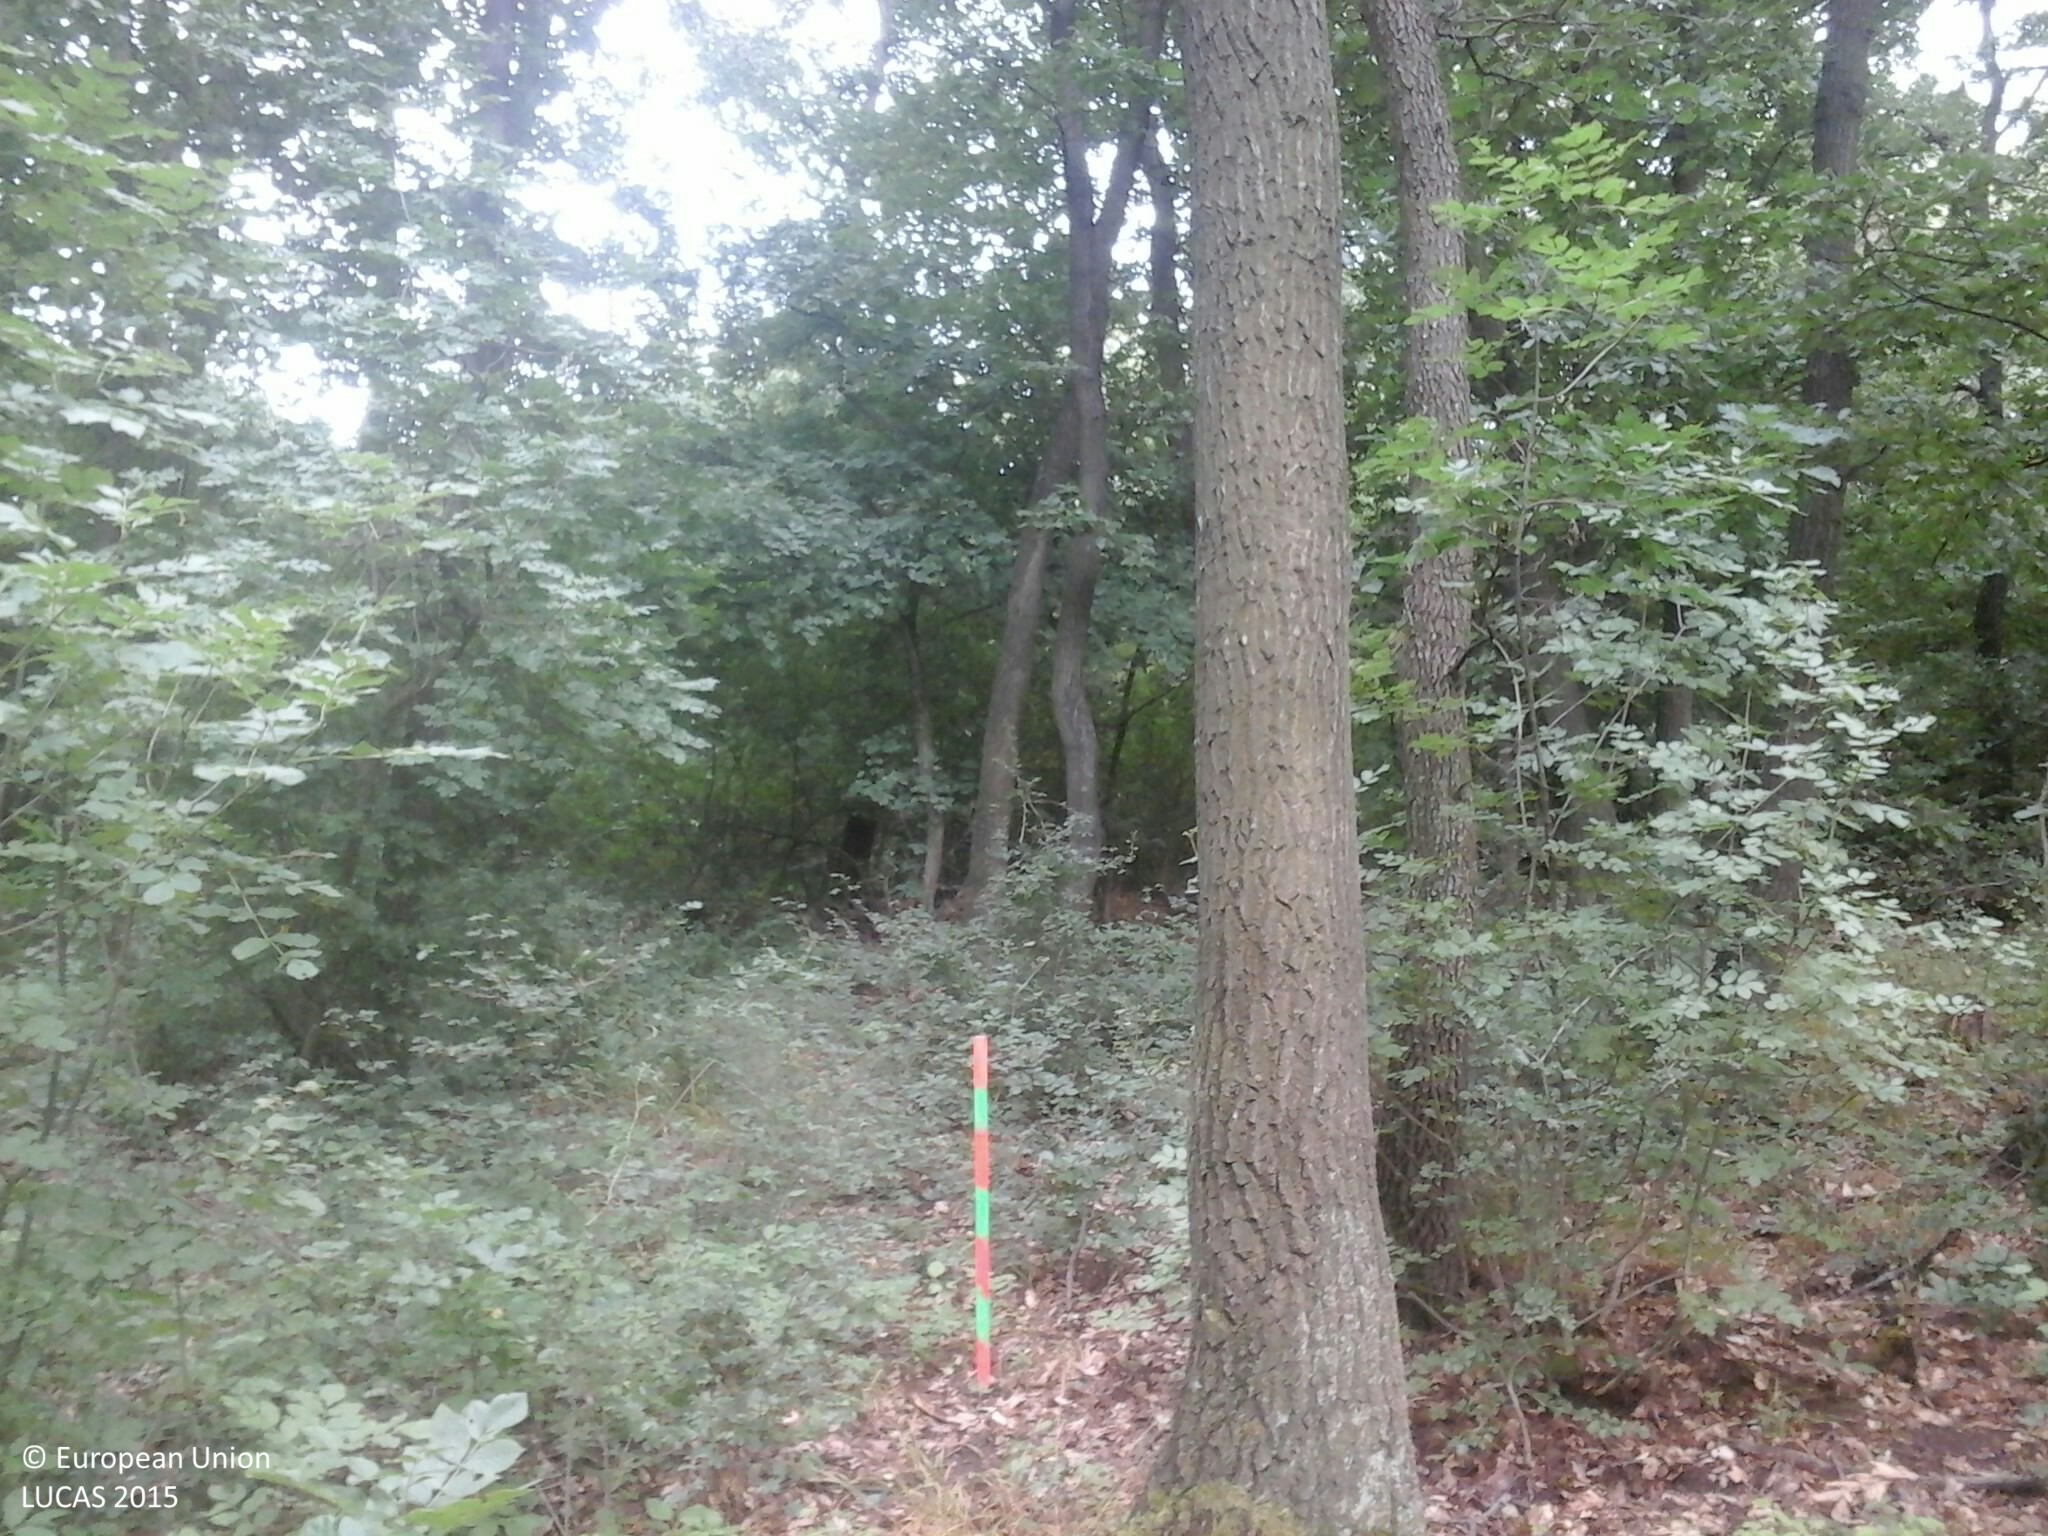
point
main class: Woodland
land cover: Broadleaved woodland
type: acidophilous oak and oak-birch forest
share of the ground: > 75 %
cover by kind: broadleaved forest trees 95 %, shrubs 5 %
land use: Forestry
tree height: > 5 m
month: July
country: HU
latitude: 46.9186
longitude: 17.7682
